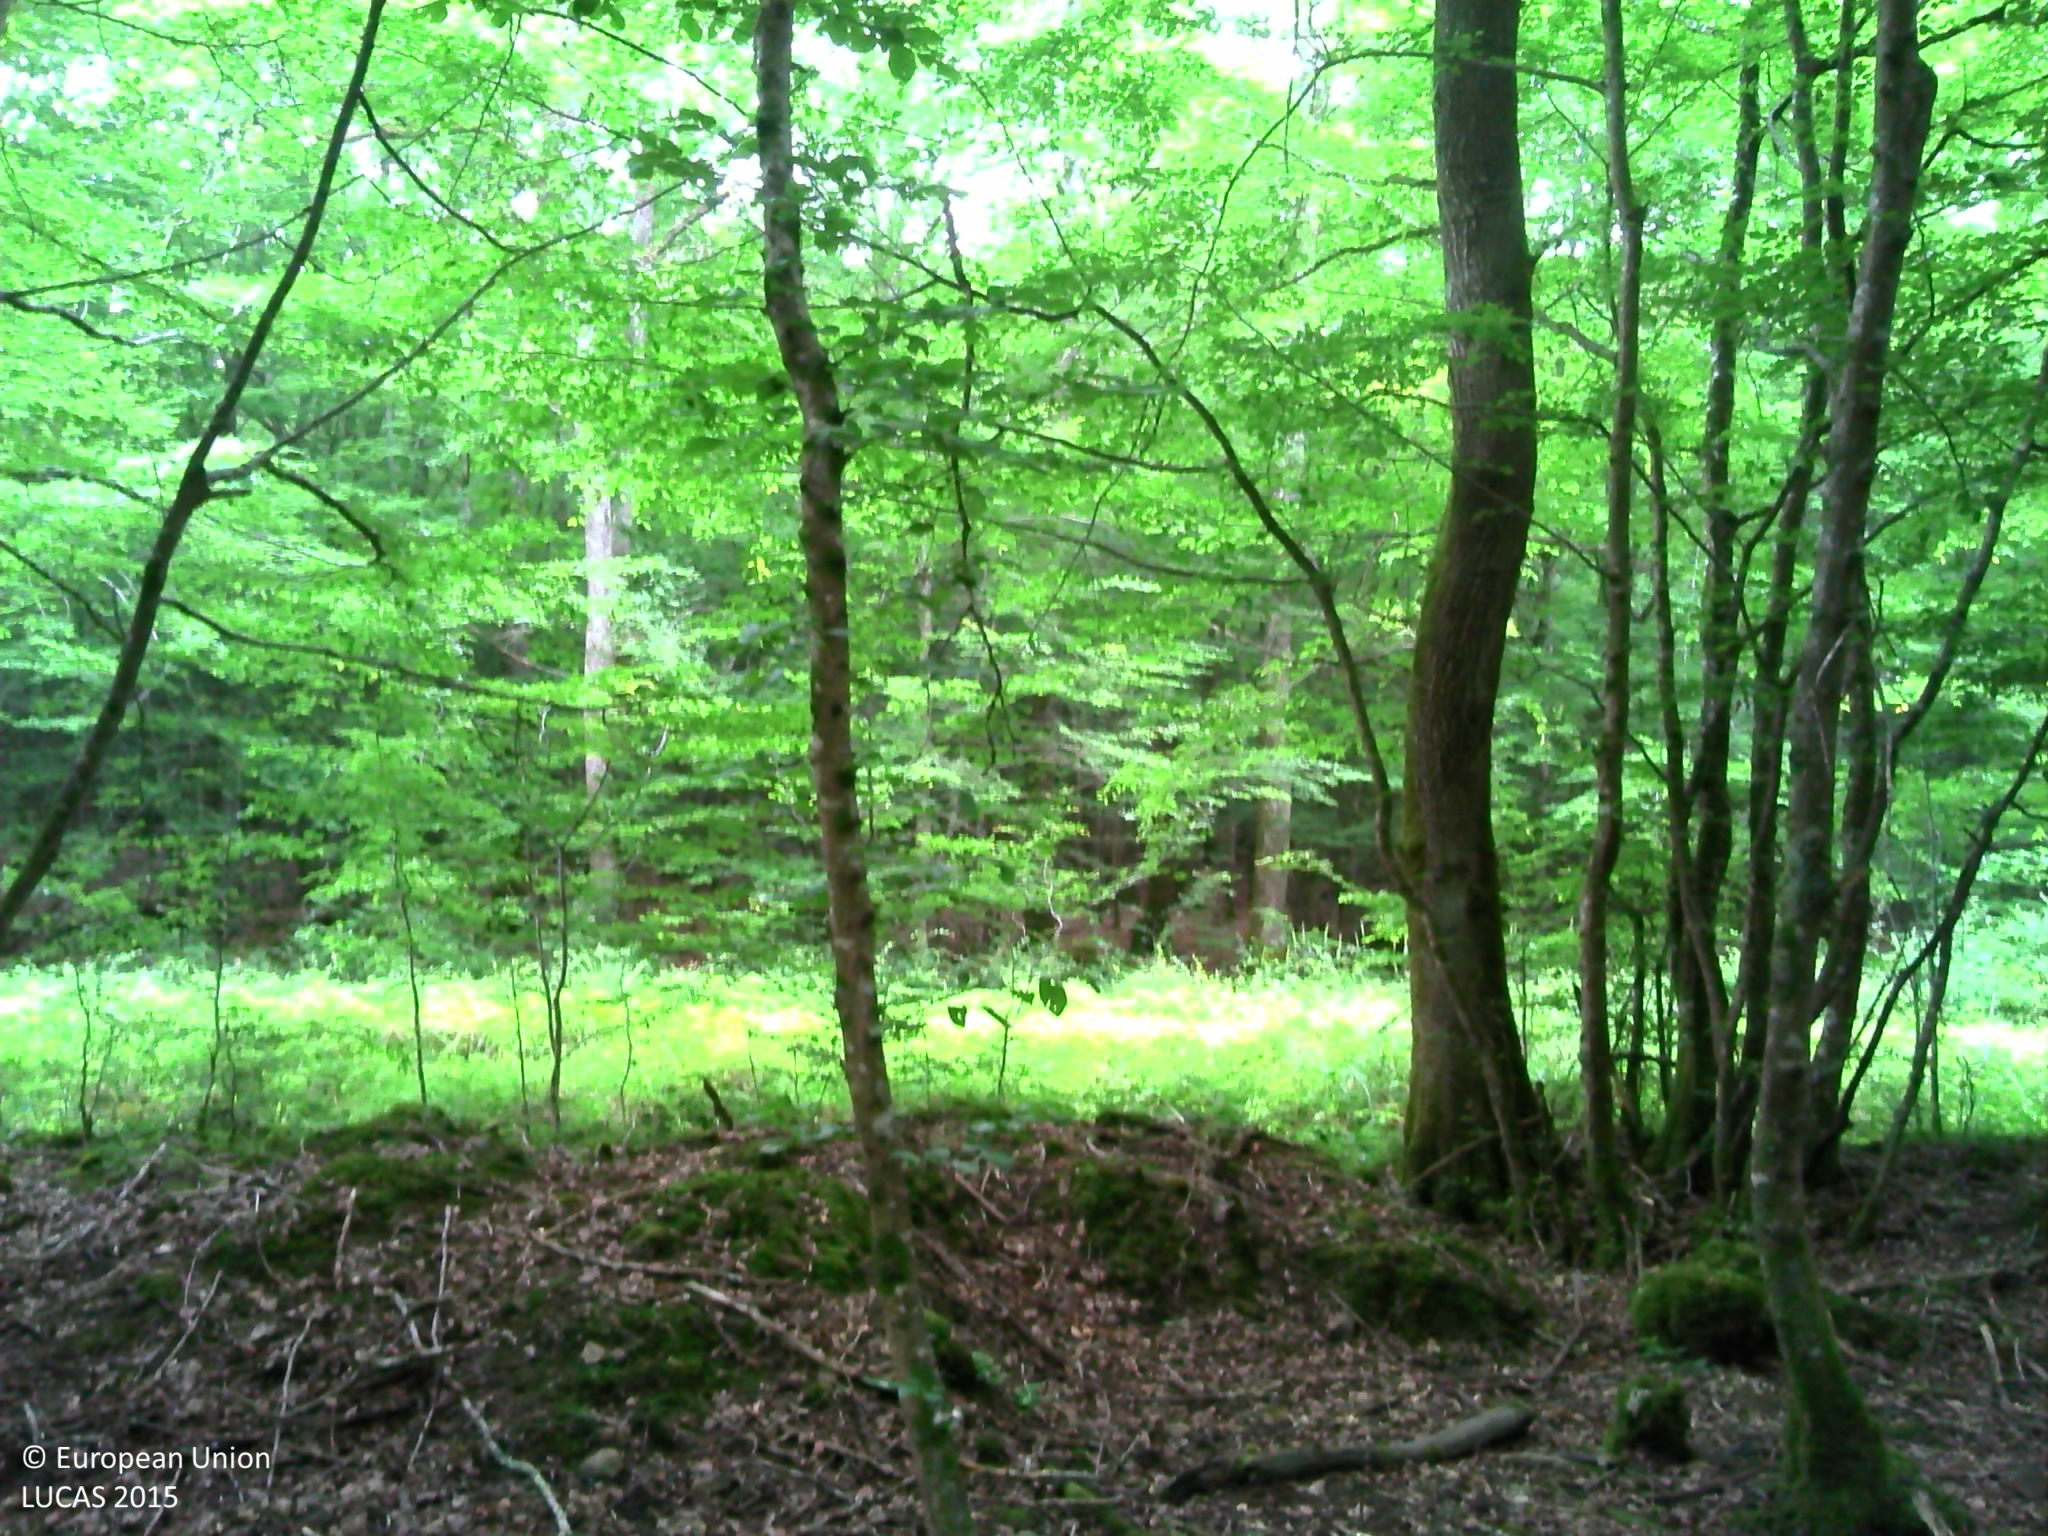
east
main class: Woodland
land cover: Broadleaved woodland
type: mesophytic deciduous forest
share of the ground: > 75 %
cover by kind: broadleaved forest trees 95 %, herbaceous plants 5 %
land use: Forestry
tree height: > 5 m
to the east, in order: Broadleaved woodland; Ditches and canals; Tracks; Ditches and canals; Broadleaved woodland
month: June
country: FR
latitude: 47.1810
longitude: 3.1737
